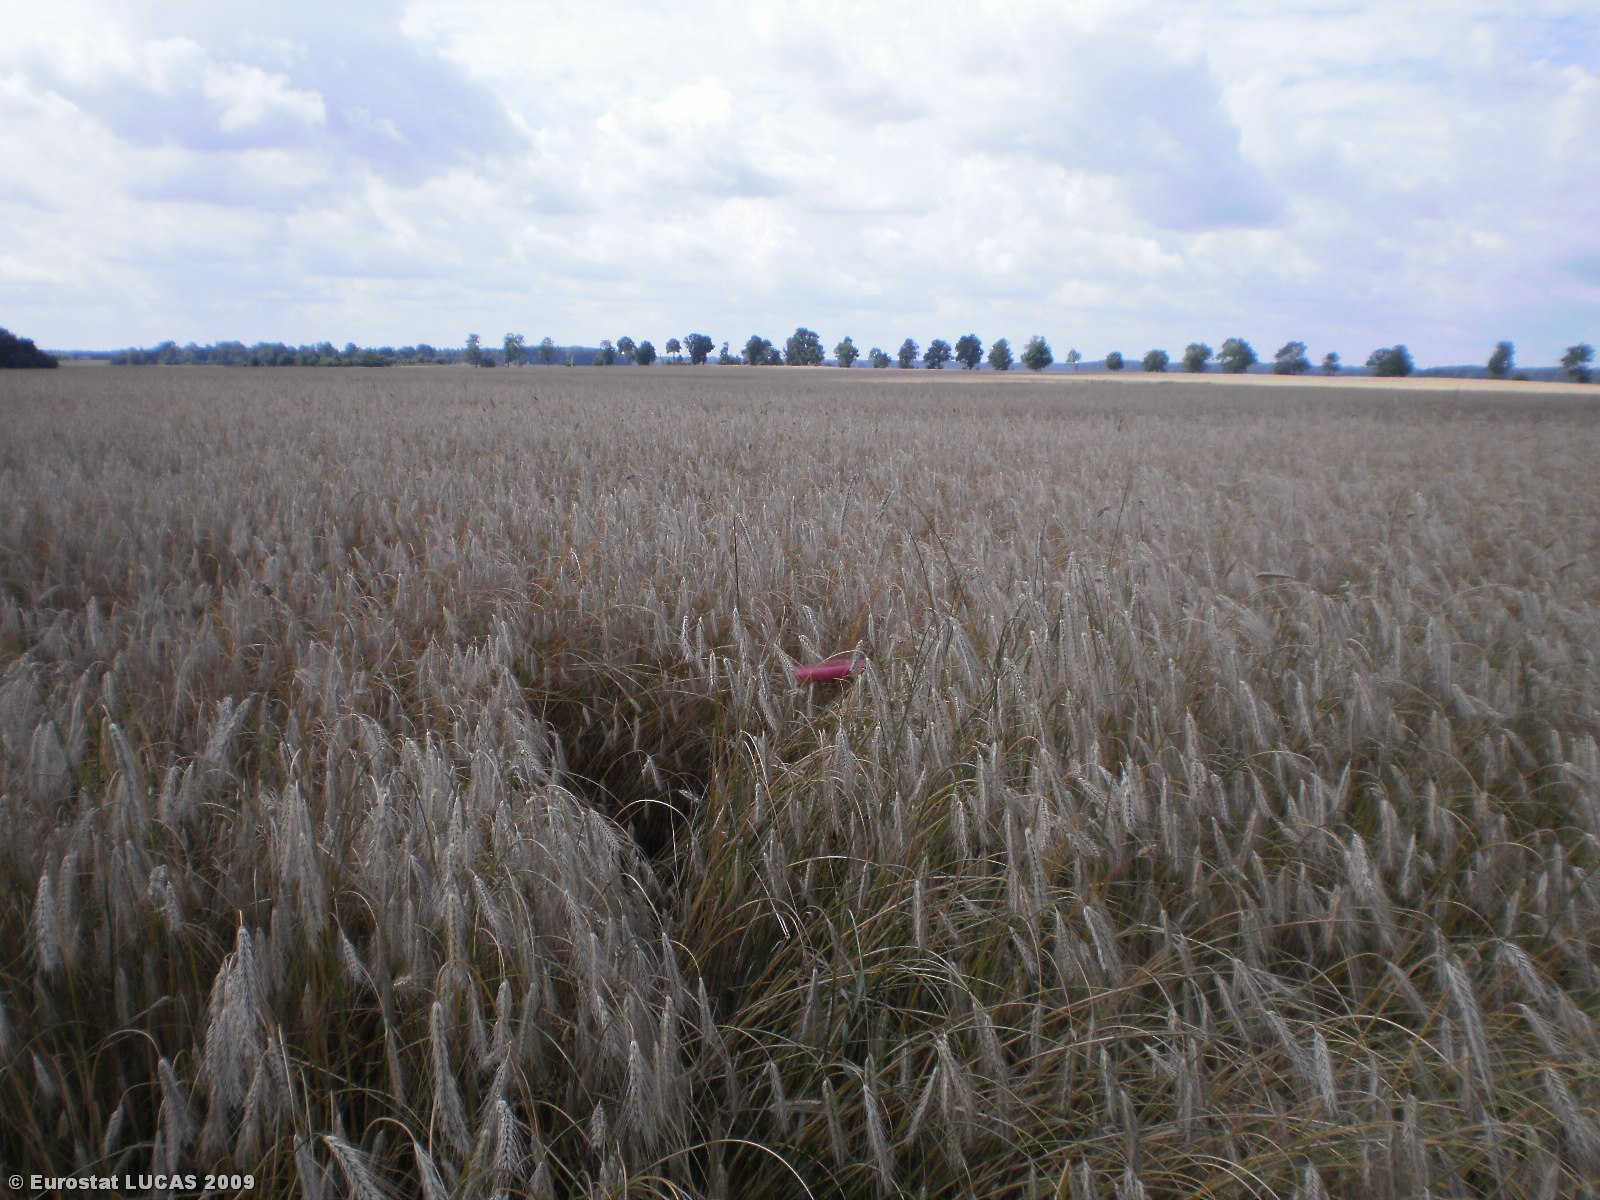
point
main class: Cropland
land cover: Rye
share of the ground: > 75 %
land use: Agriculture (excluding fallow land and kitchen gardens)
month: July
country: LT
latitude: 56.0635
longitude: 25.1958
